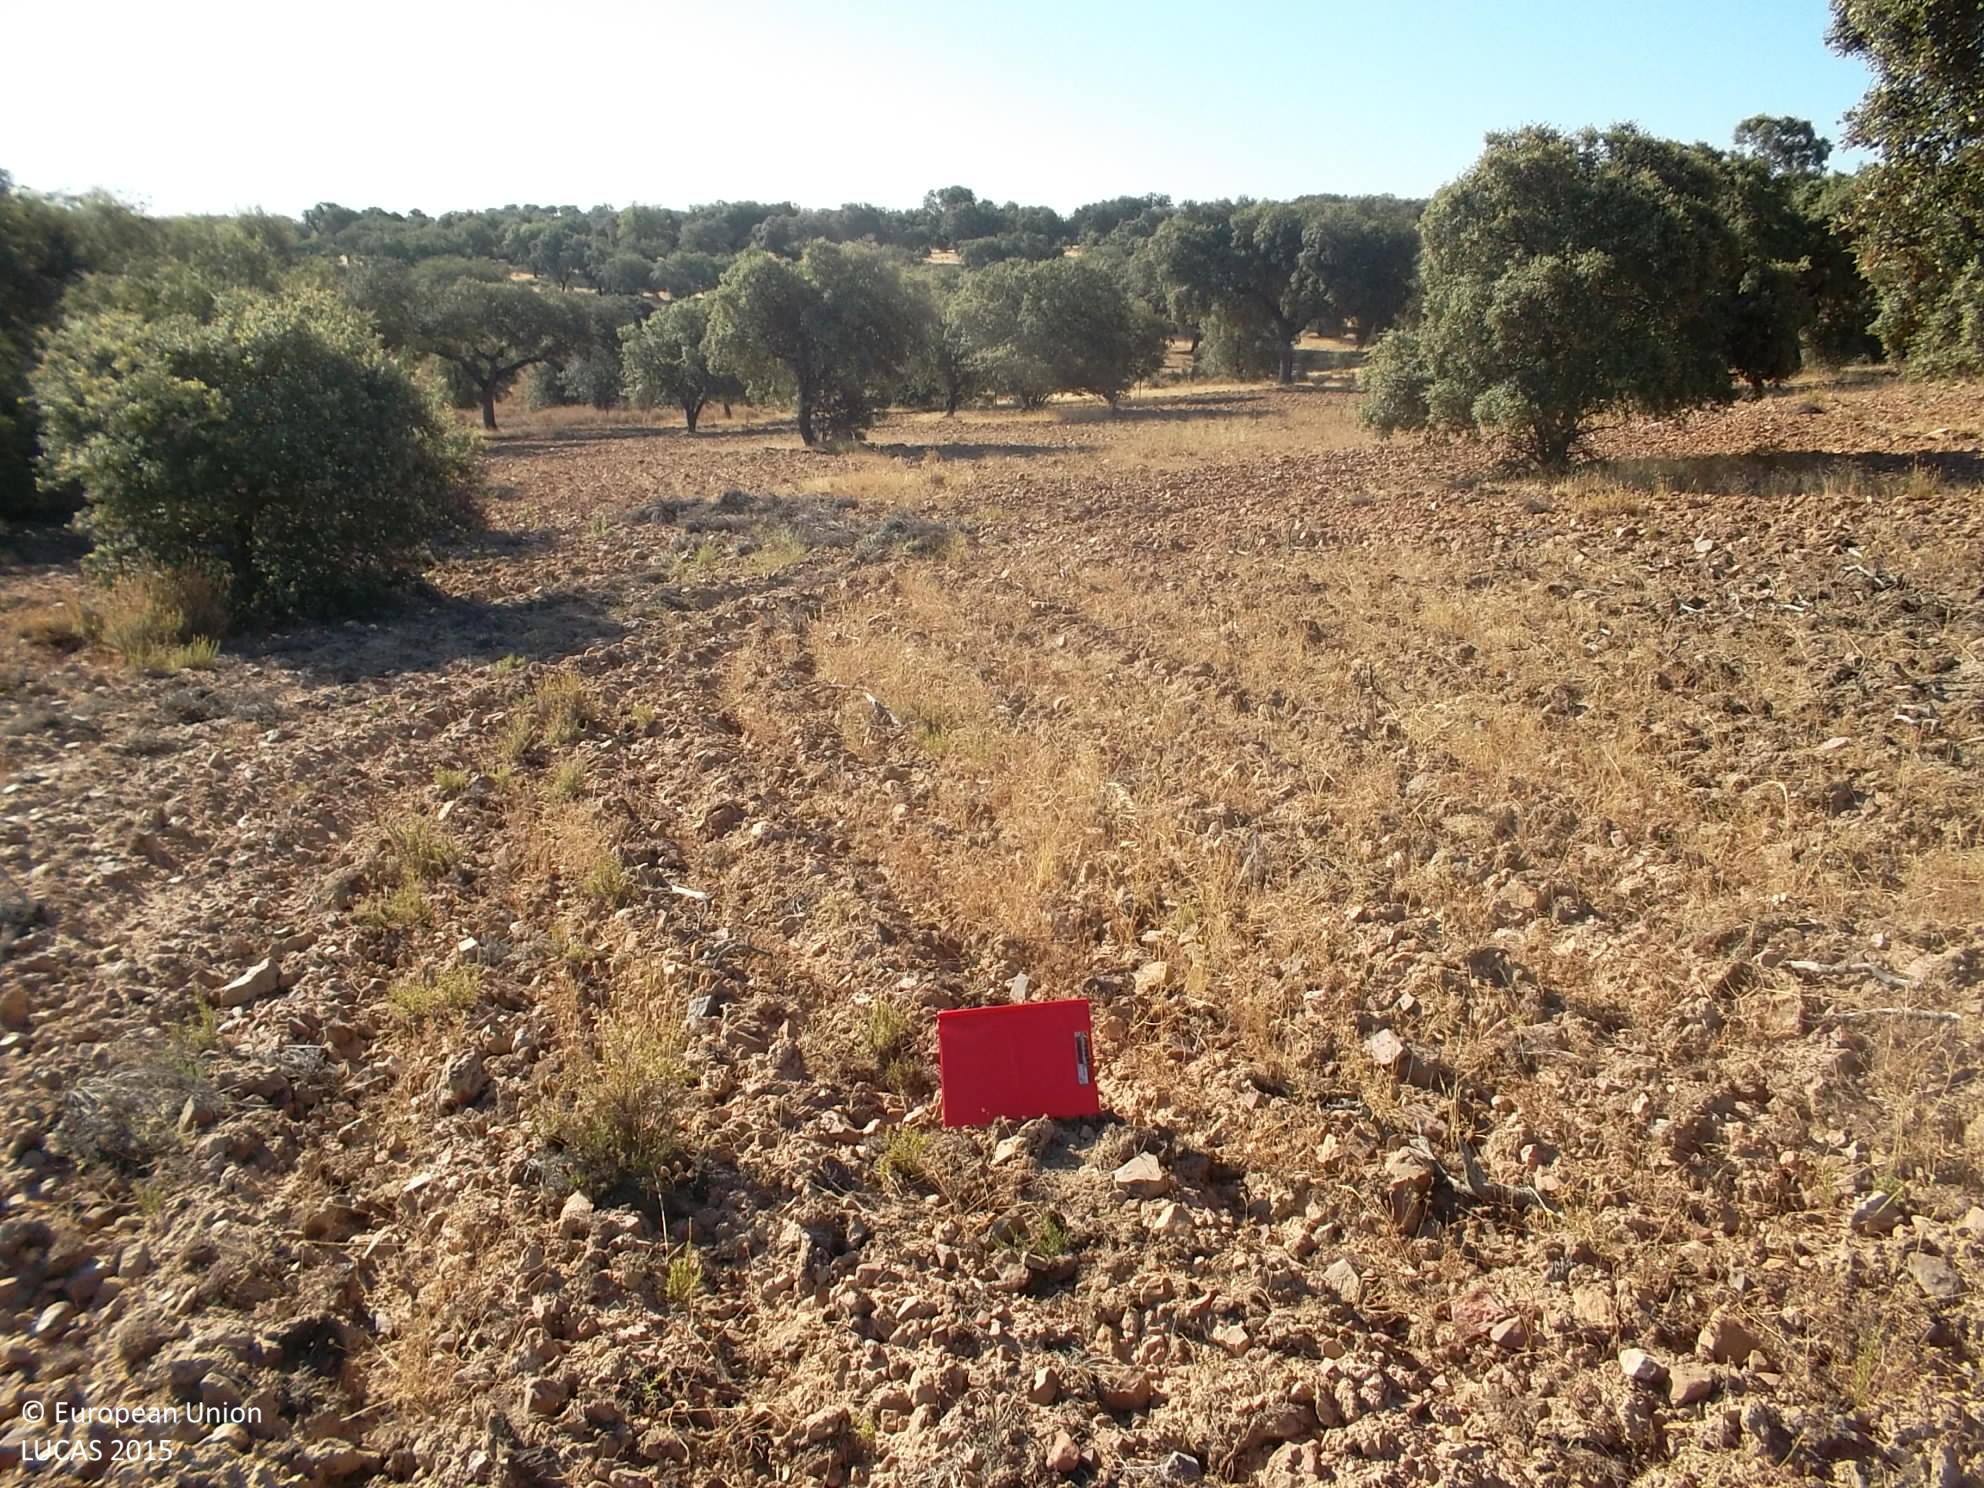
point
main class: Woodland
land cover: Broadleaved woodland
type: broadleaved evergreen forest
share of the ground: 10 - 25 %
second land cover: Grassland without tree/shrub cover
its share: 10 - 25 %
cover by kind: herbaceous plants 80 %, broadleaved forest trees 20 %
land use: Forestry
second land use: Agriculture (excluding fallow land and kitchen gardens)
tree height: > 5 m
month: July
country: ES
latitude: 38.4909
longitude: -5.8513
